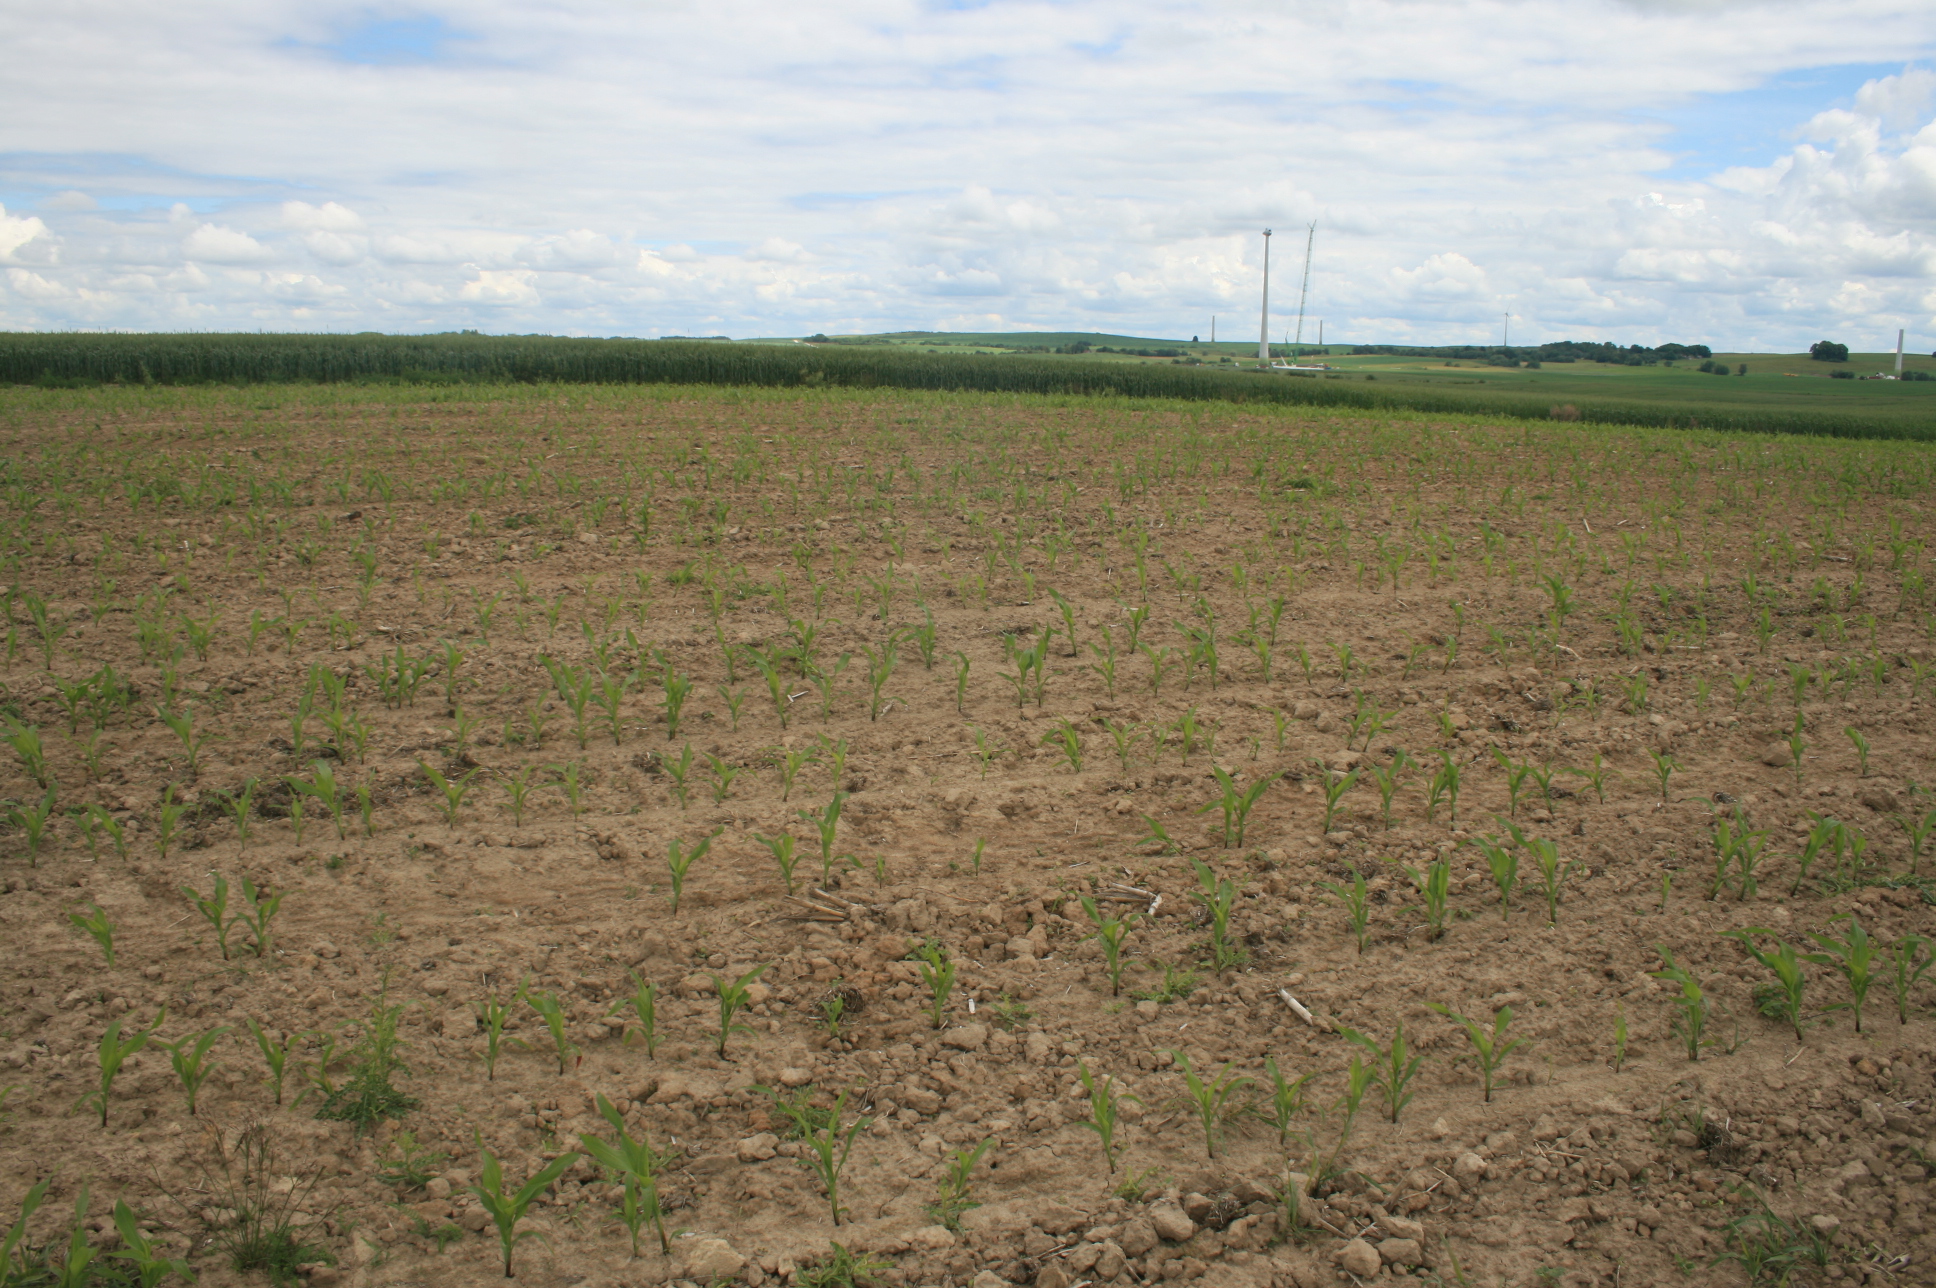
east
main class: Cropland
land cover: Maize
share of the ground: 25 - 50 %
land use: Agriculture (excluding fallow land and kitchen gardens)
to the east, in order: Maize; Common wheat; Electric lines; Common wheat
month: June
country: LT
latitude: 55.1465
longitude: 22.0262
